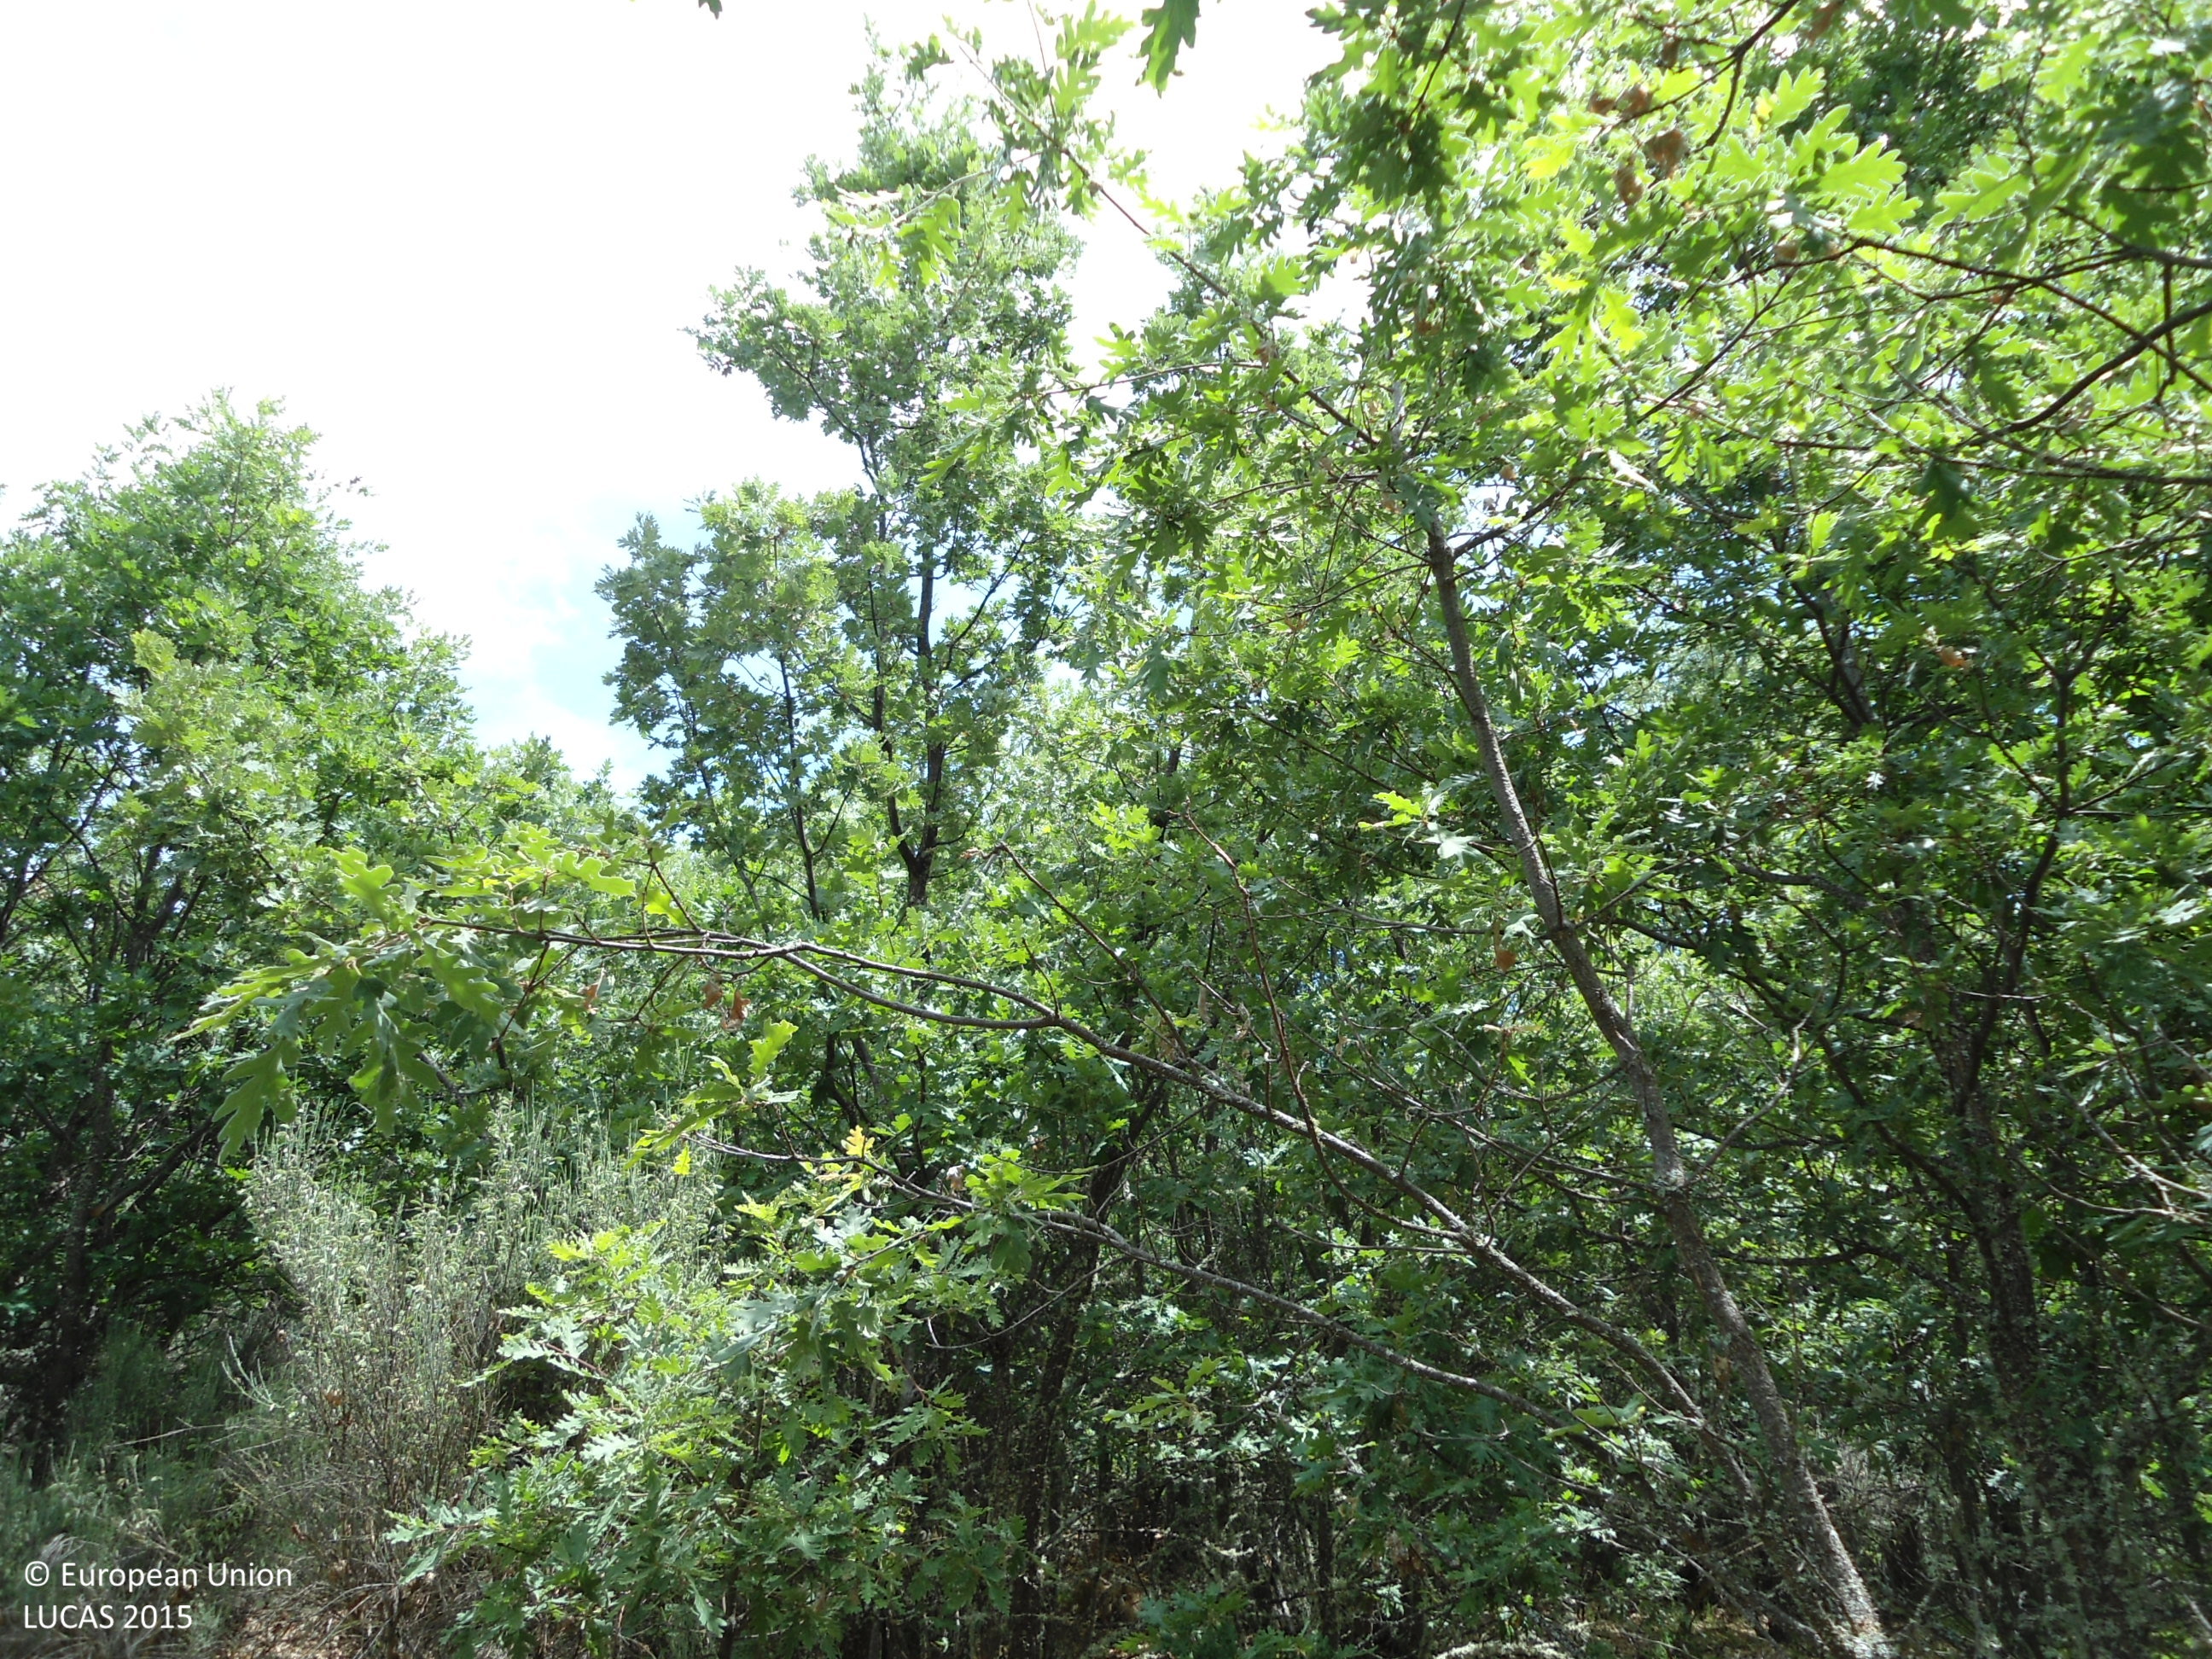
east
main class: Woodland
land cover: Broadleaved woodland
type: thermophilous deciduous forest
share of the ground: > 75 %
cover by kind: broadleaved forest trees 85 %, shrubs 10 %, herbaceous plants 5 %
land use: Forestry
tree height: > 5 m
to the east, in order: Broadleaved woodland
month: June
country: ES
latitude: 42.0706
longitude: -6.5615
